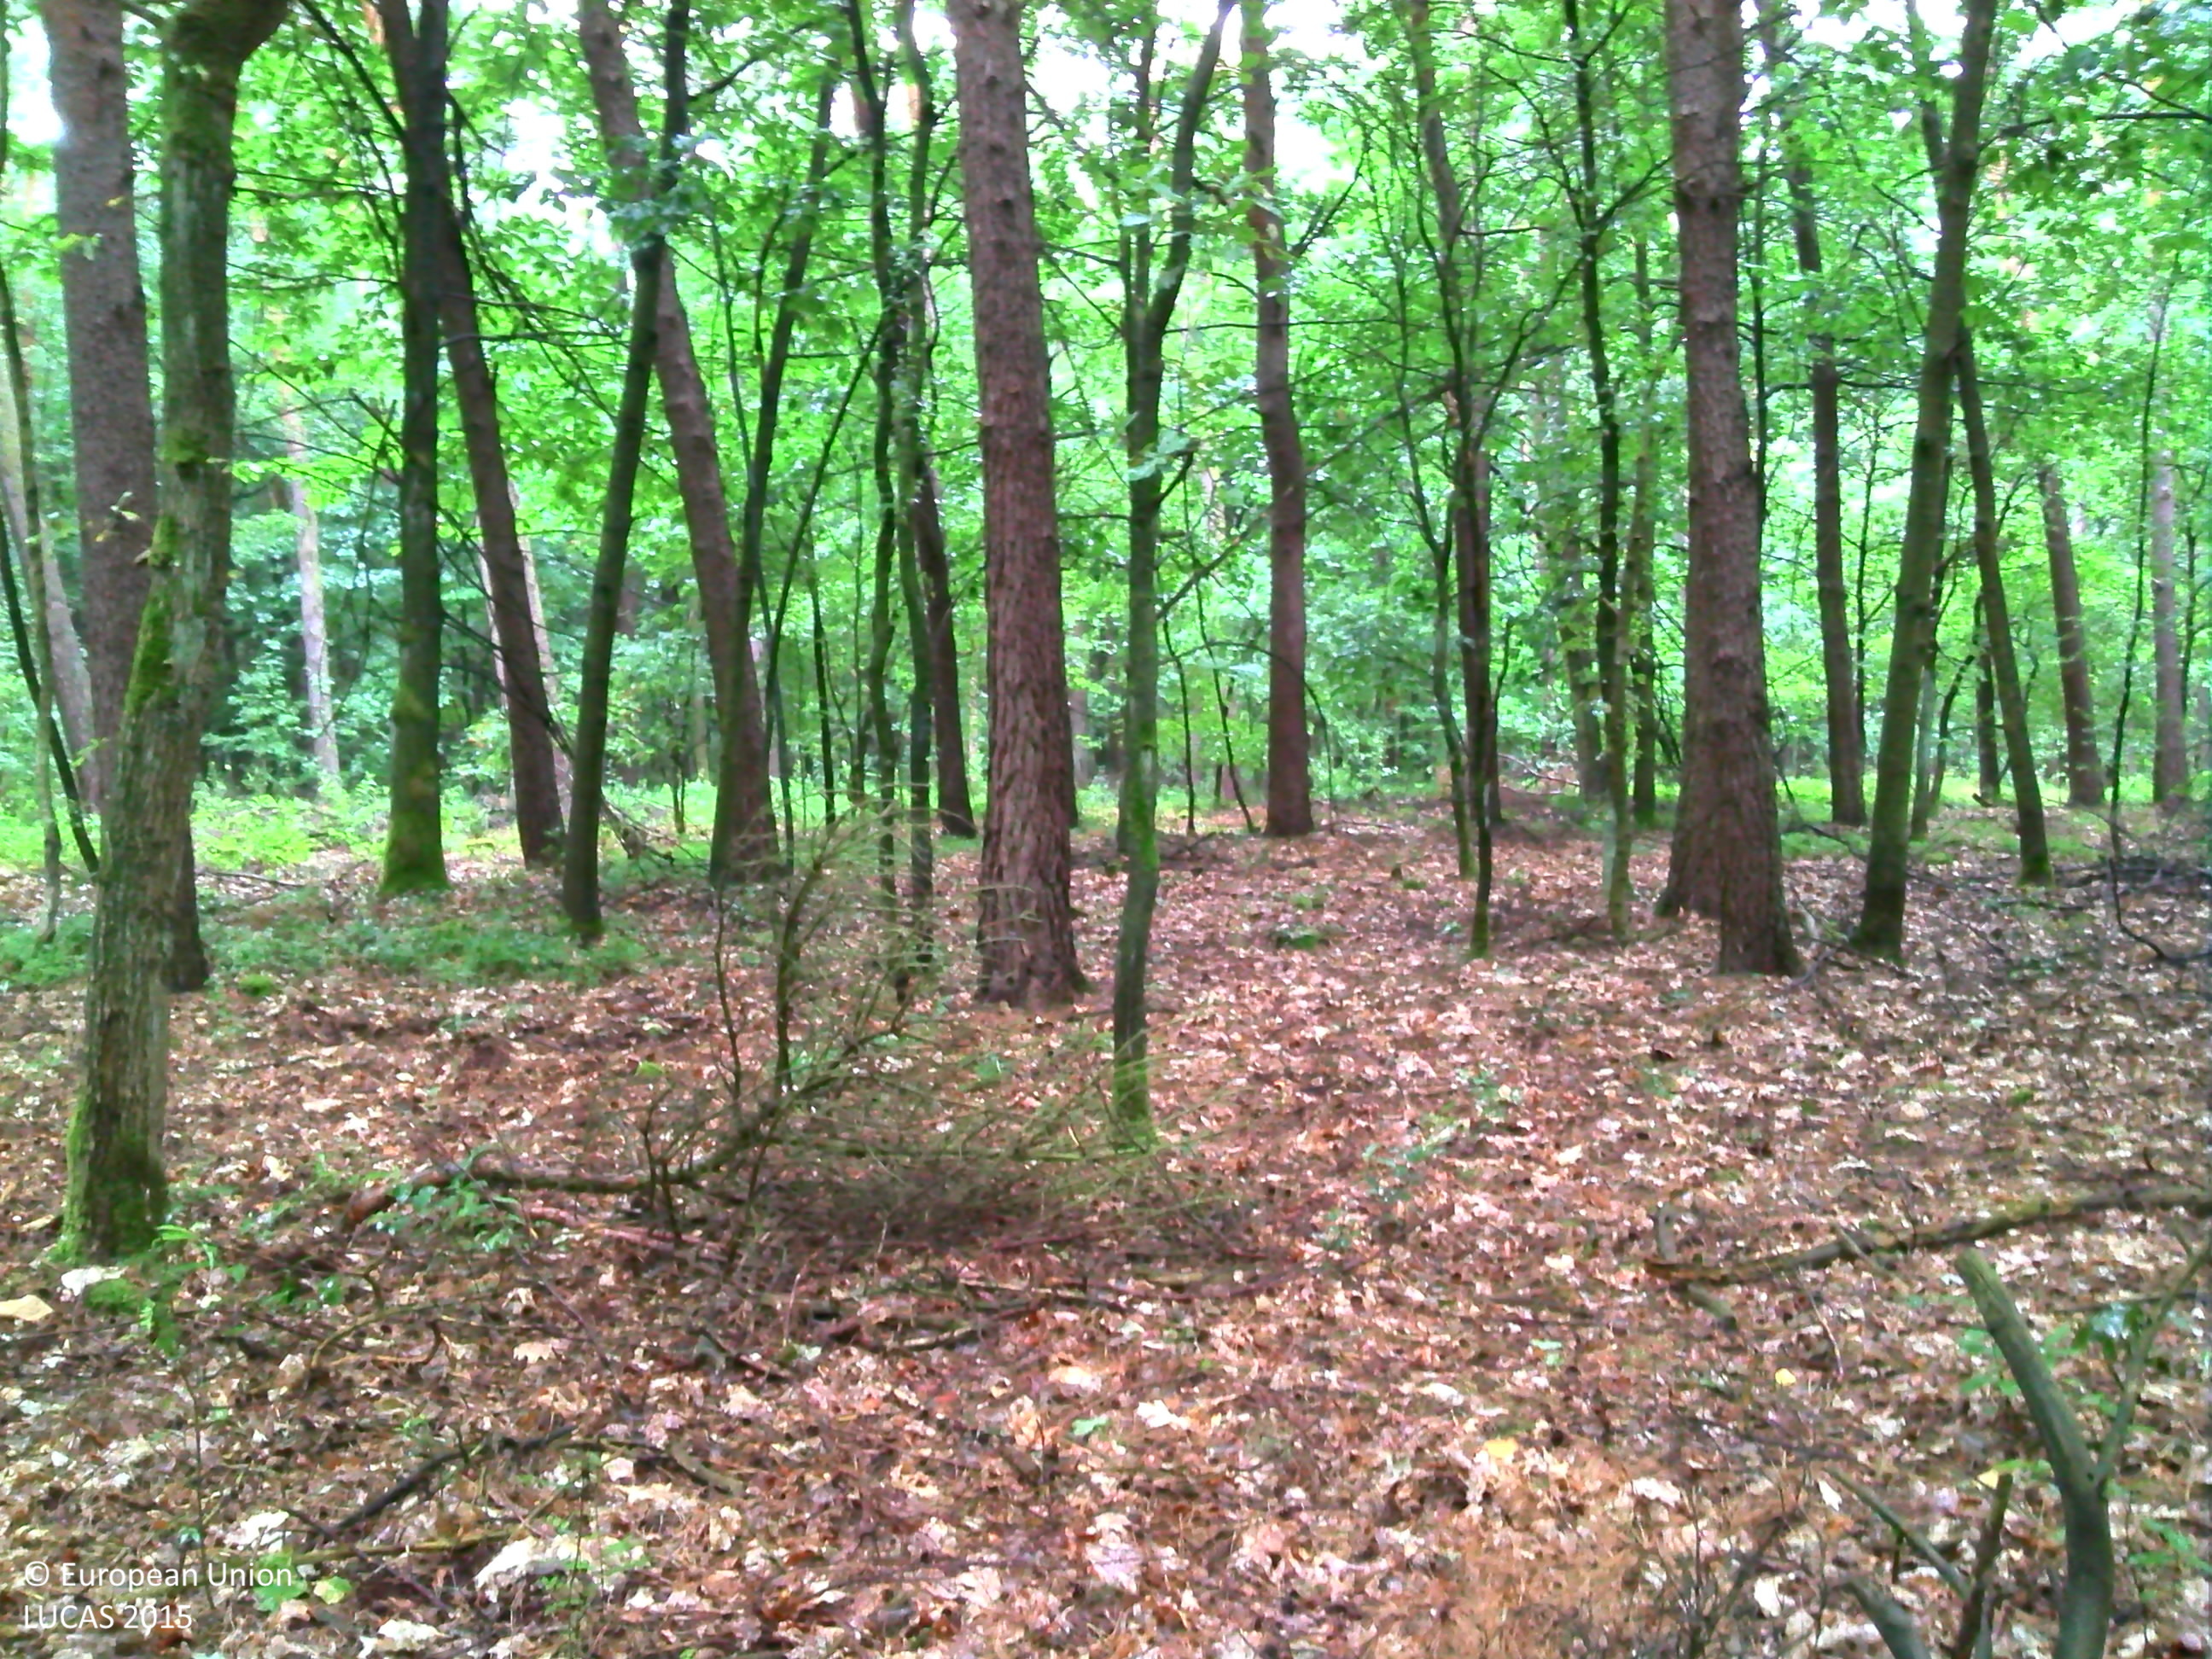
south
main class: Woodland
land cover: Pine dominated mixed woodland
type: mesophytic deciduous forest
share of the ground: > 75 %
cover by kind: coniferous forest trees 65 %, broadleaved forest trees 35 %
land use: Forestry
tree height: > 5 m
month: August
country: BE
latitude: 50.9805
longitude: 5.5685
